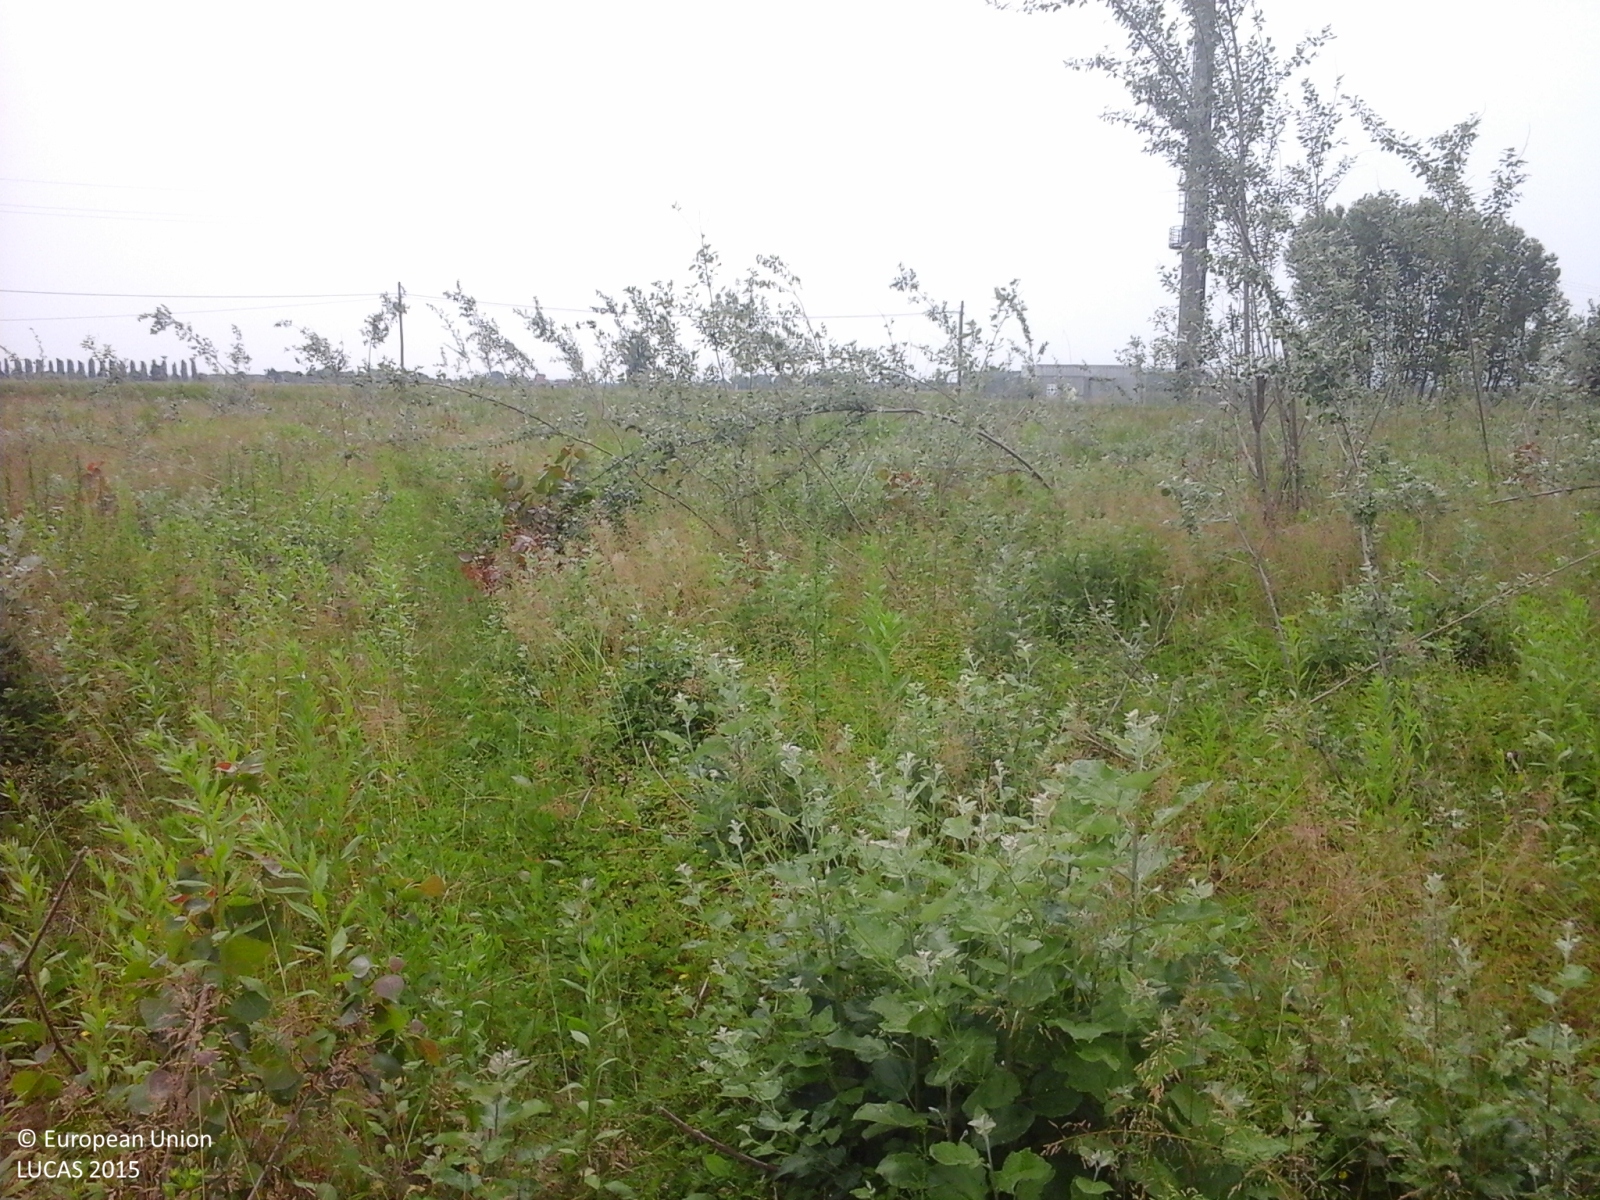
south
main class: Grassland
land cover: Grassland with sparse tree/shrub cover
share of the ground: > 75 %
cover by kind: herbaceous plants 90 %, broadleaved forest trees 5 %, shrubs 5 %
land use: Forestry
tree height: < 5 m
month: May
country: IT
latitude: 45.2863
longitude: 9.3764
